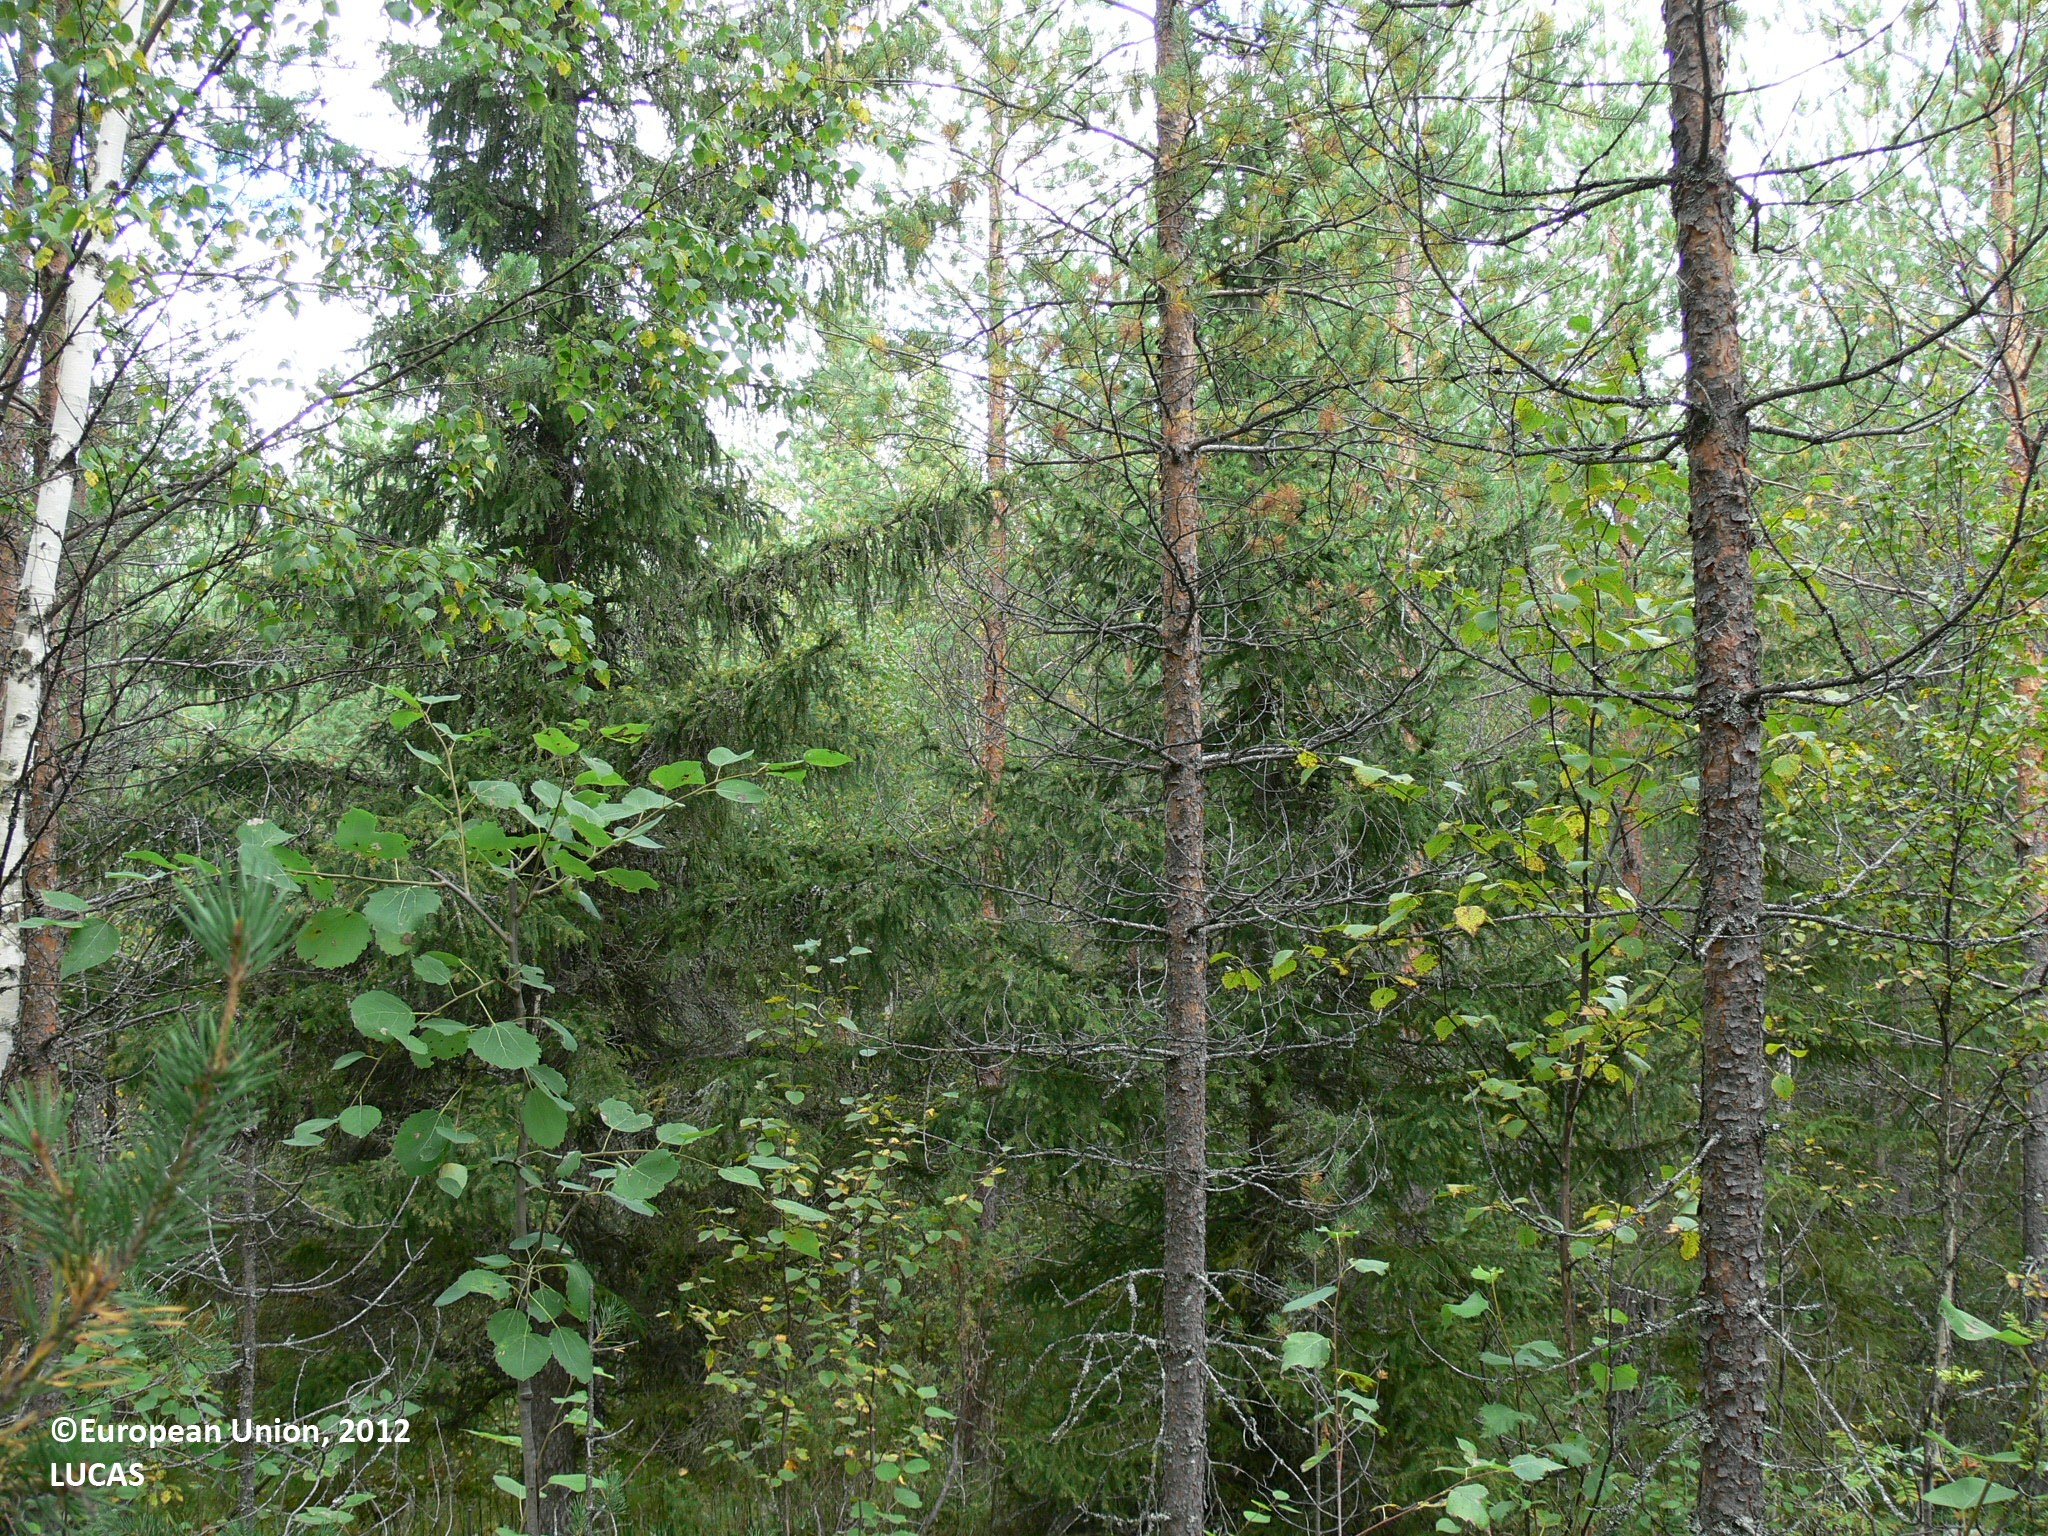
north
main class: Woodland
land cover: Other mixed woodland
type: boreal forest
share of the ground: > 75 %
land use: Forestry
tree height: > 5 m
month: August
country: FI
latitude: 63.2861
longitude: 30.3025
